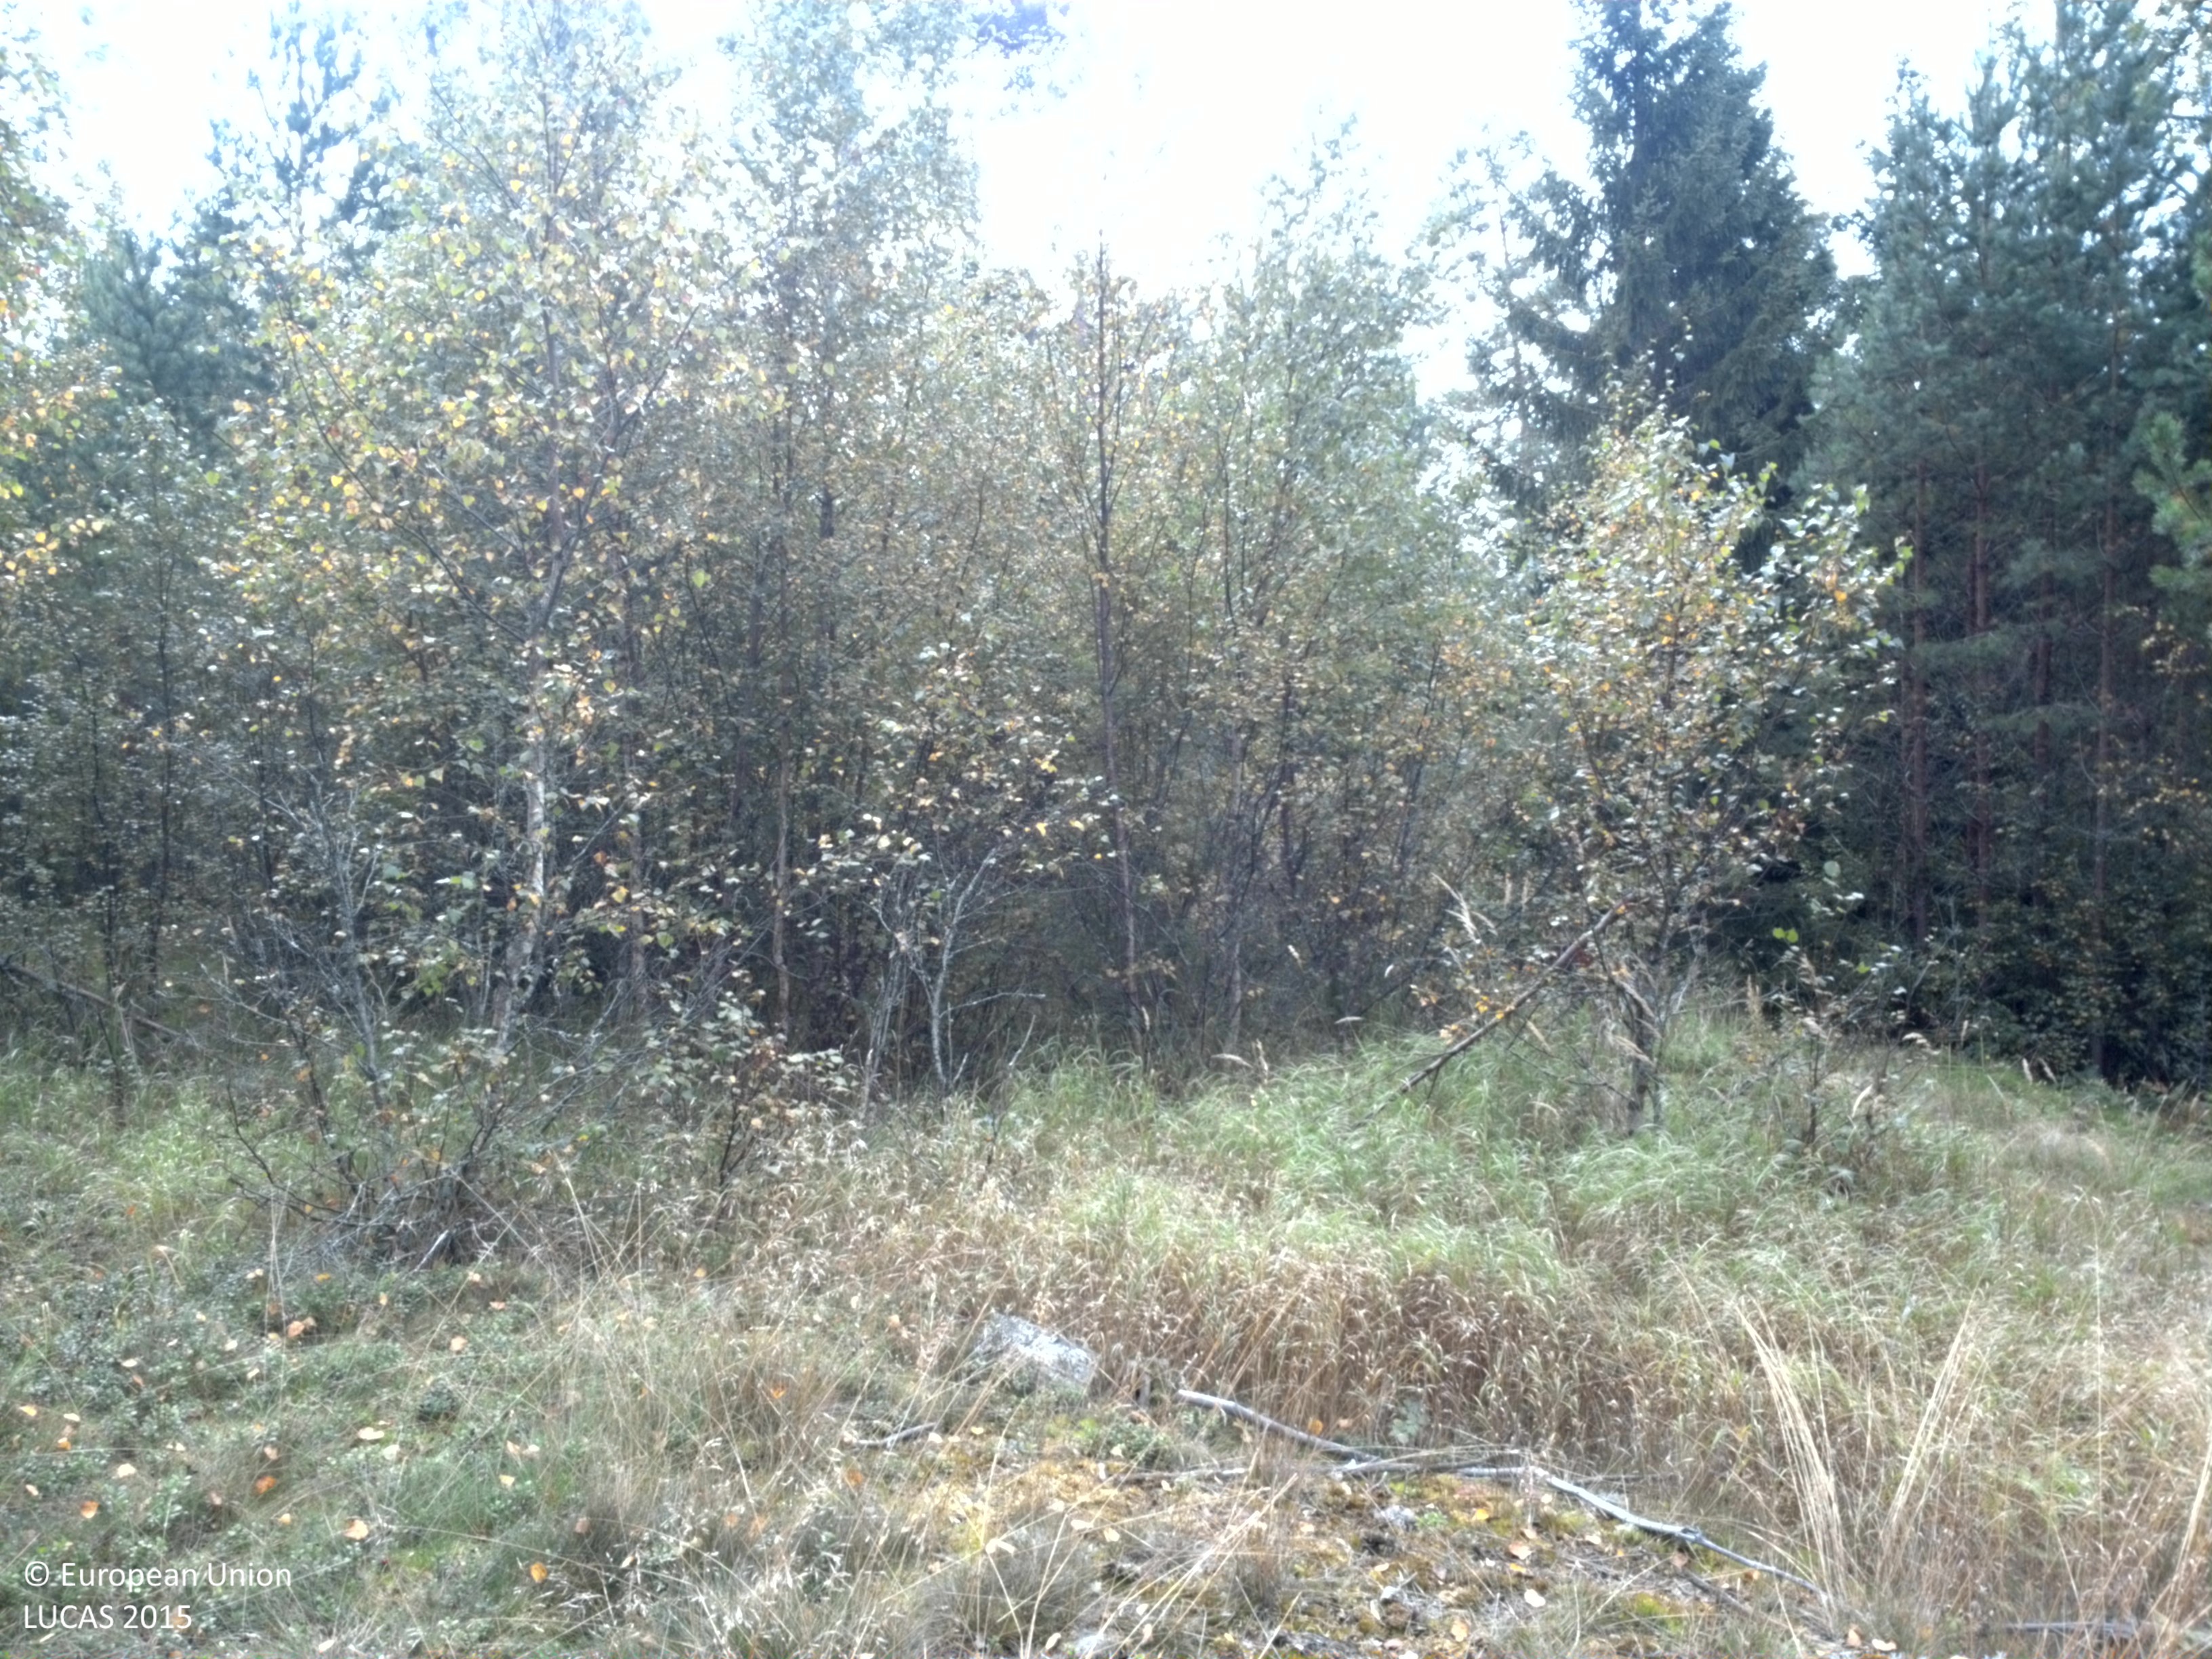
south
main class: Woodland
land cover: Spruce dominated mixed woodland
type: boreal forest
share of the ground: 25 - 50 %
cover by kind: coniferous forest trees 30 %, lichens and mosses 30 %, herbaceous plants 25 %, broadleaved forest trees 10 %, consolidated bare surface 5 %
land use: Forestry
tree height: > 5 m
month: September
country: SE
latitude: 59.2533
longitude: 18.5065
